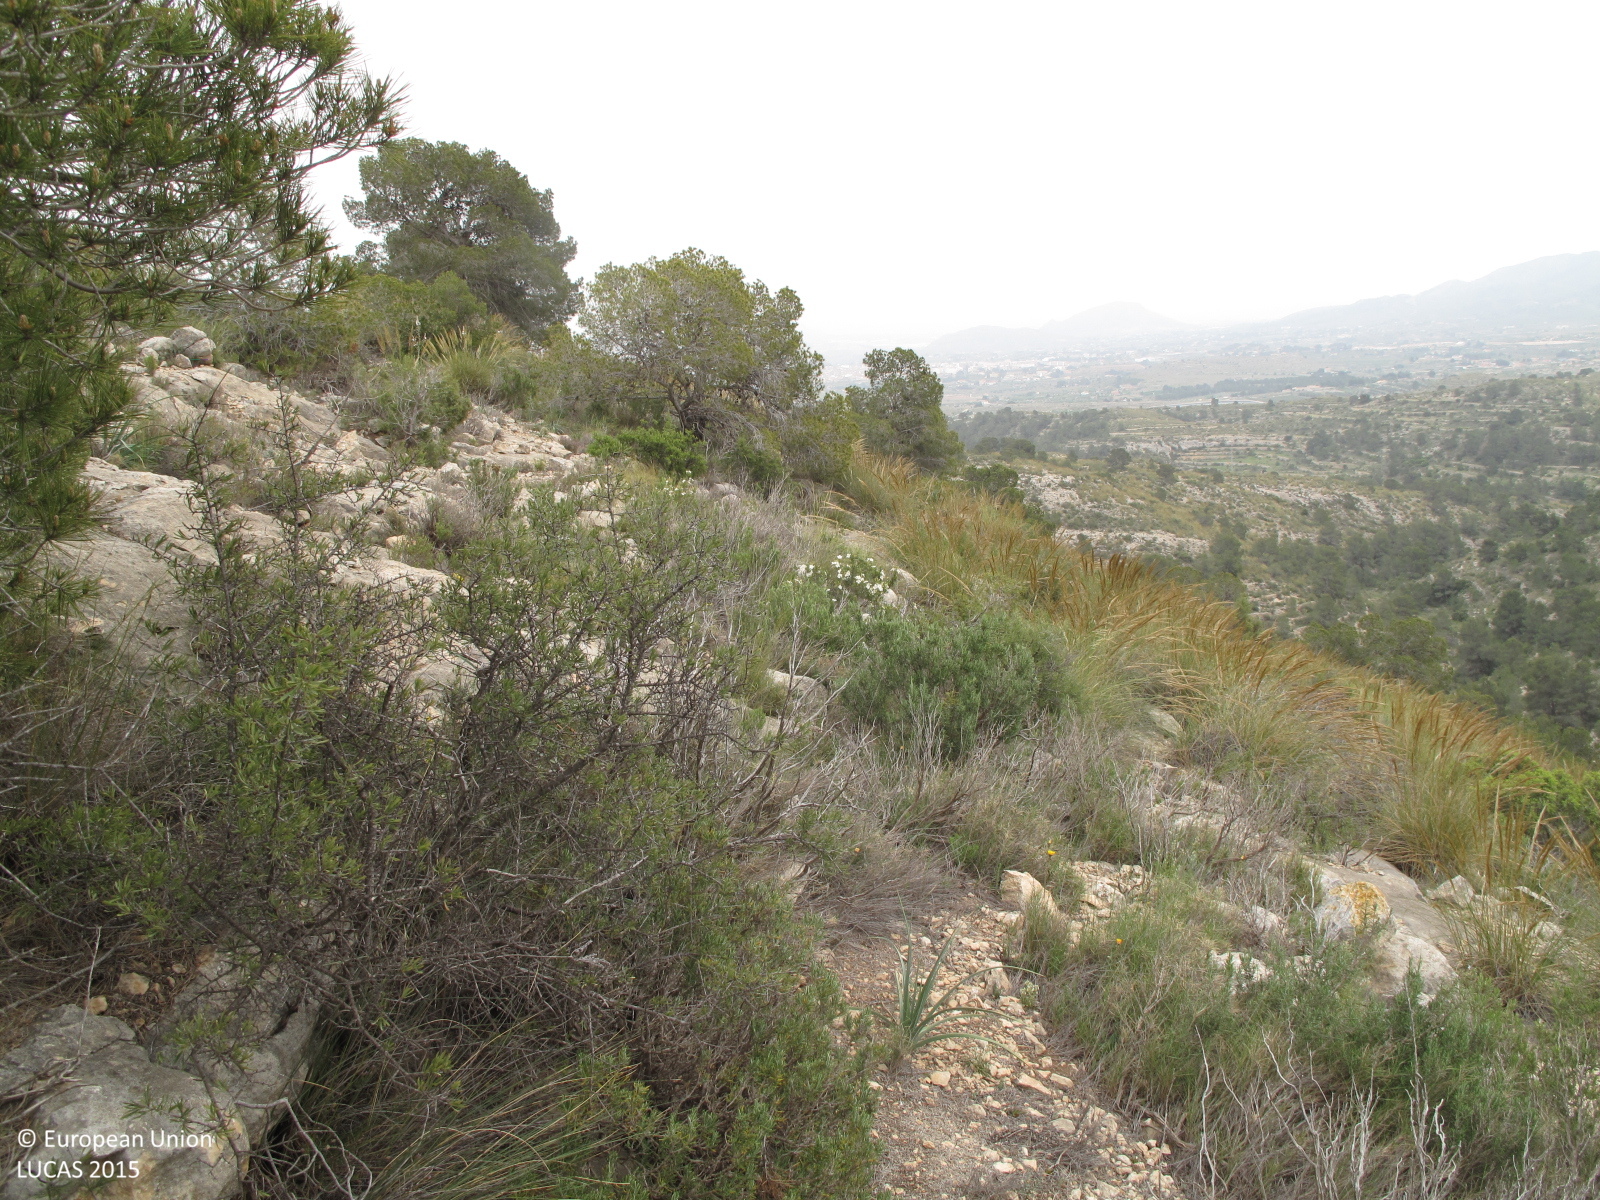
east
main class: Woodland
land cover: Pine dominated coniferous woodland
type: coniferous forest of the mediterranean region
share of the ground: 10 - 25 %
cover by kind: consolidated bare surface 70 %, coniferous forest trees 15 %, herbaceous plants 10 %, shrubs 5 %
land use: Semi-natural and natural areas not in use
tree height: > 5 m
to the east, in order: Pine dominated coniferous woodland
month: April
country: ES
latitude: 38.4549
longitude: -0.8860
